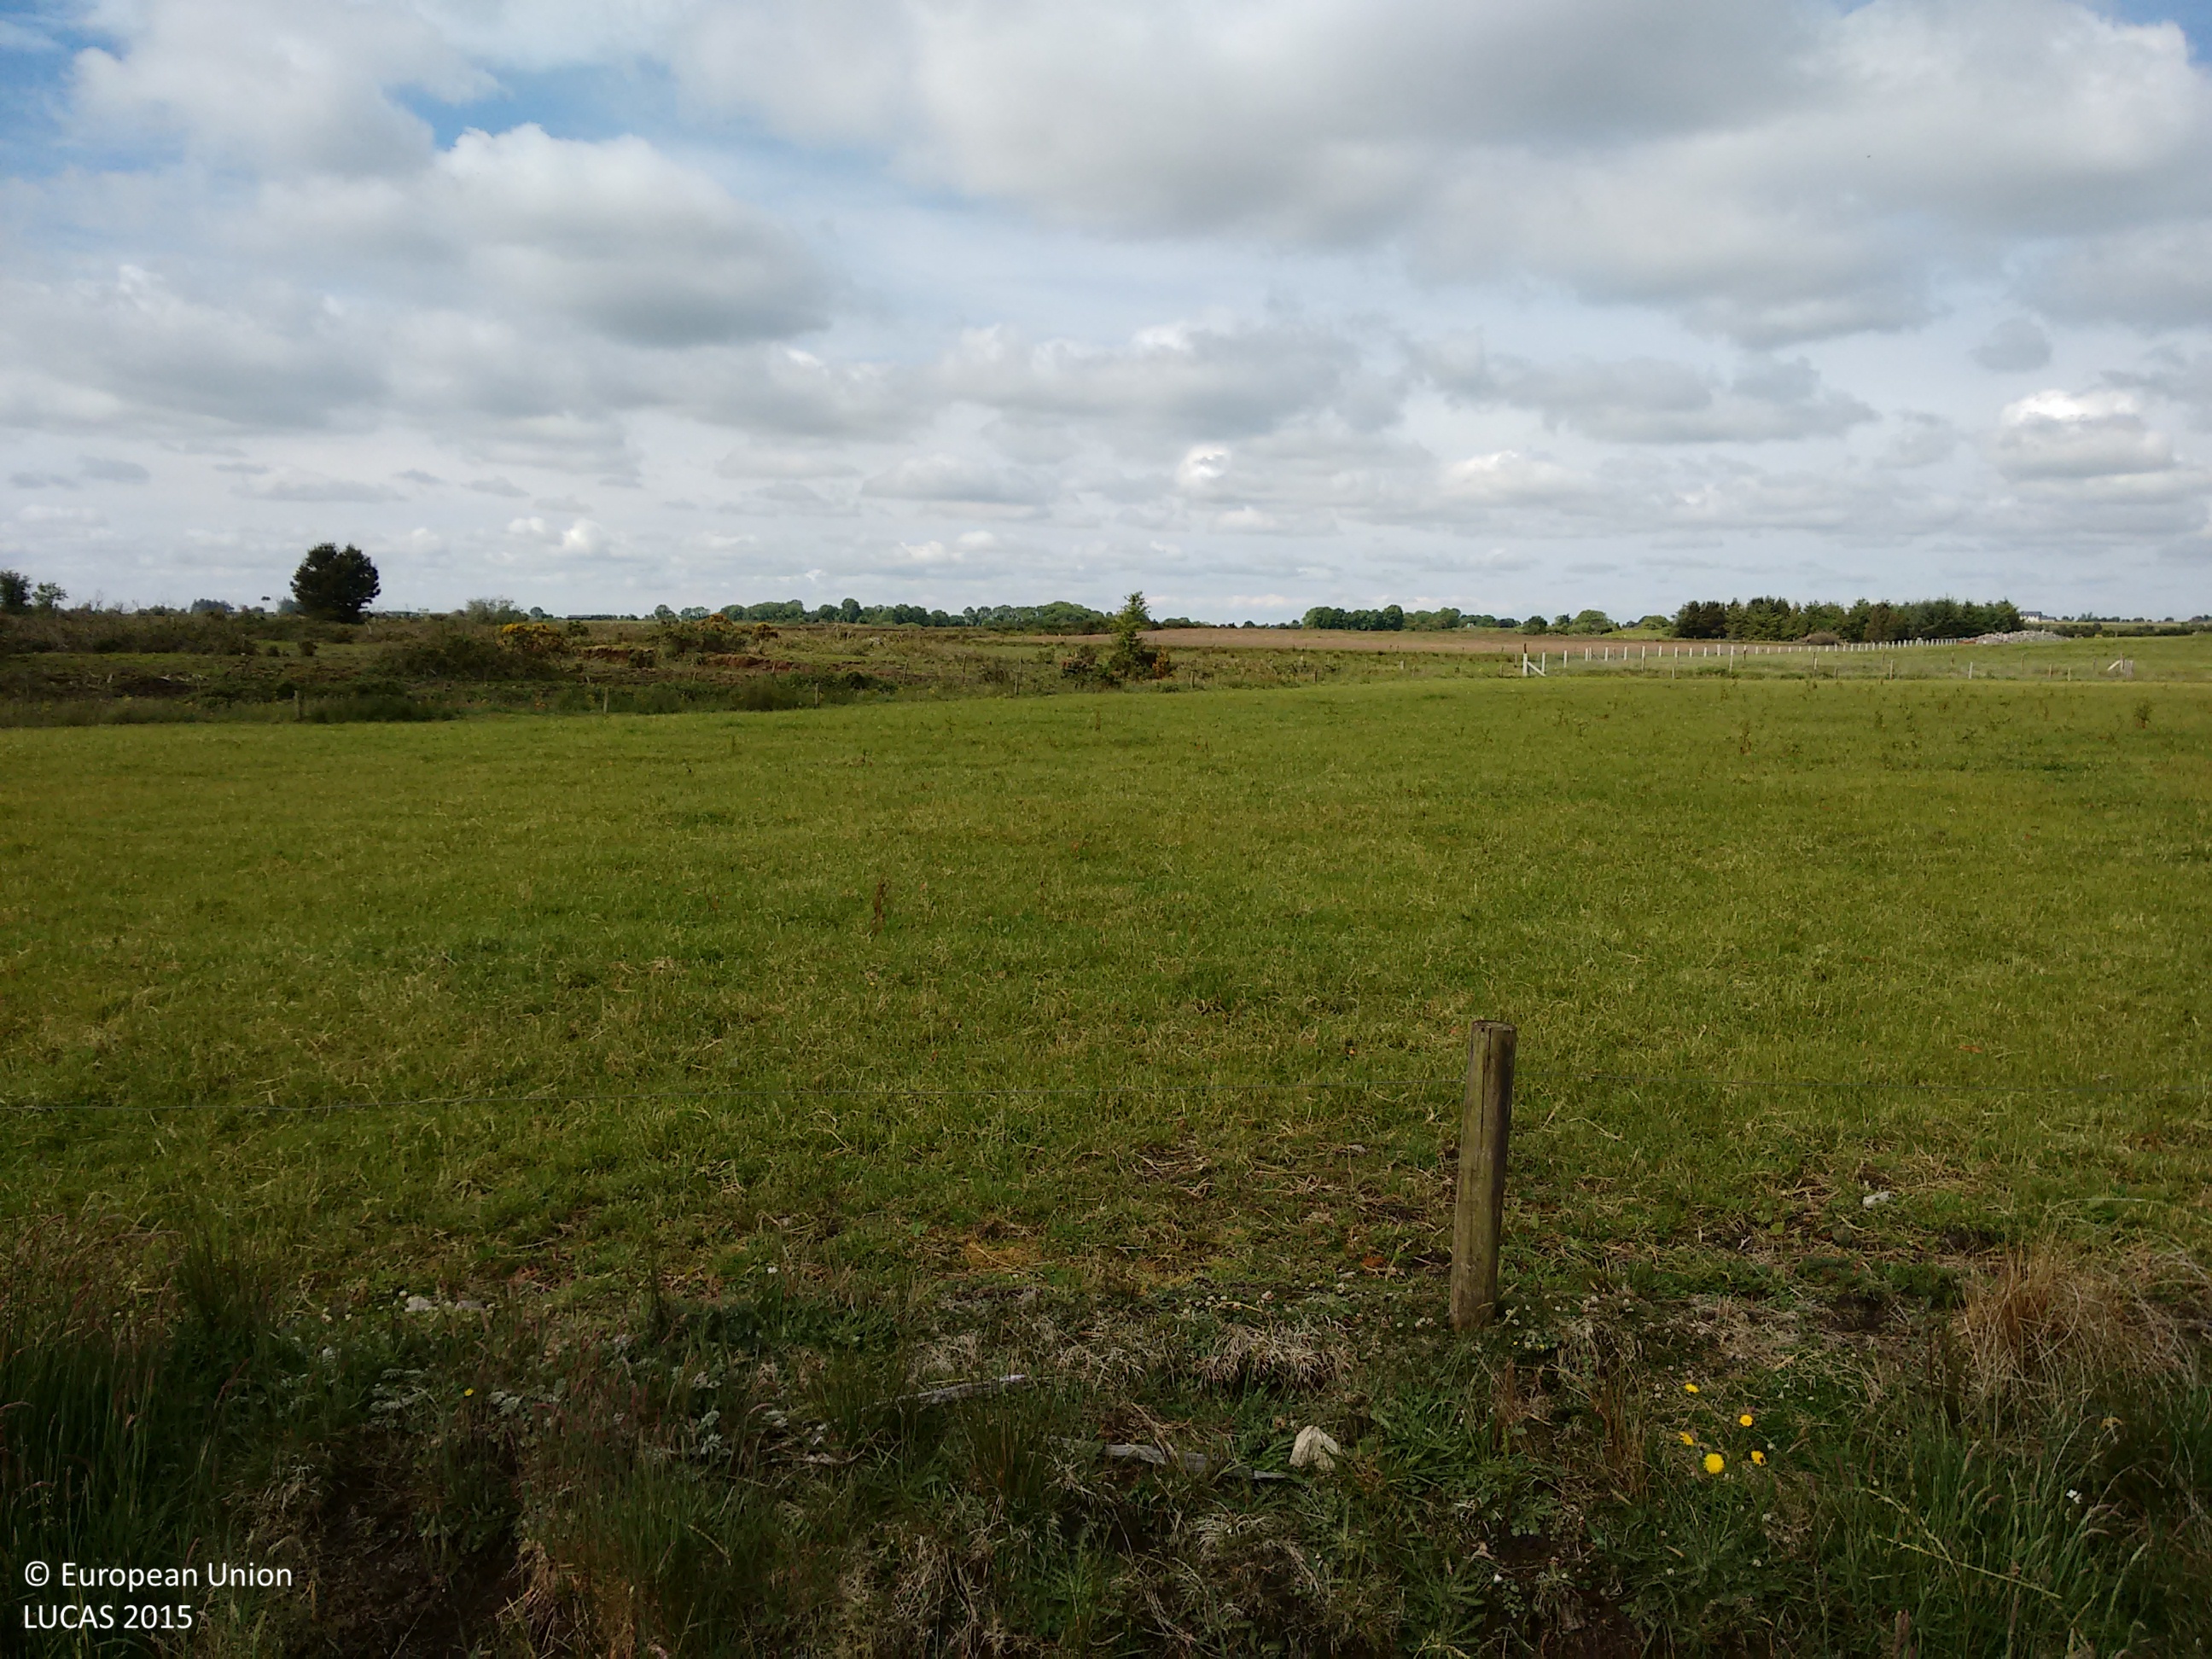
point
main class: Shrubland
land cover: Shrubland without tree cover
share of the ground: > 75 %
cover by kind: shrubs 80 %, herbaceous plants 20 %
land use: Agriculture (excluding fallow land and kitchen gardens)
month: June
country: IE
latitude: 53.5370
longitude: -8.6836
